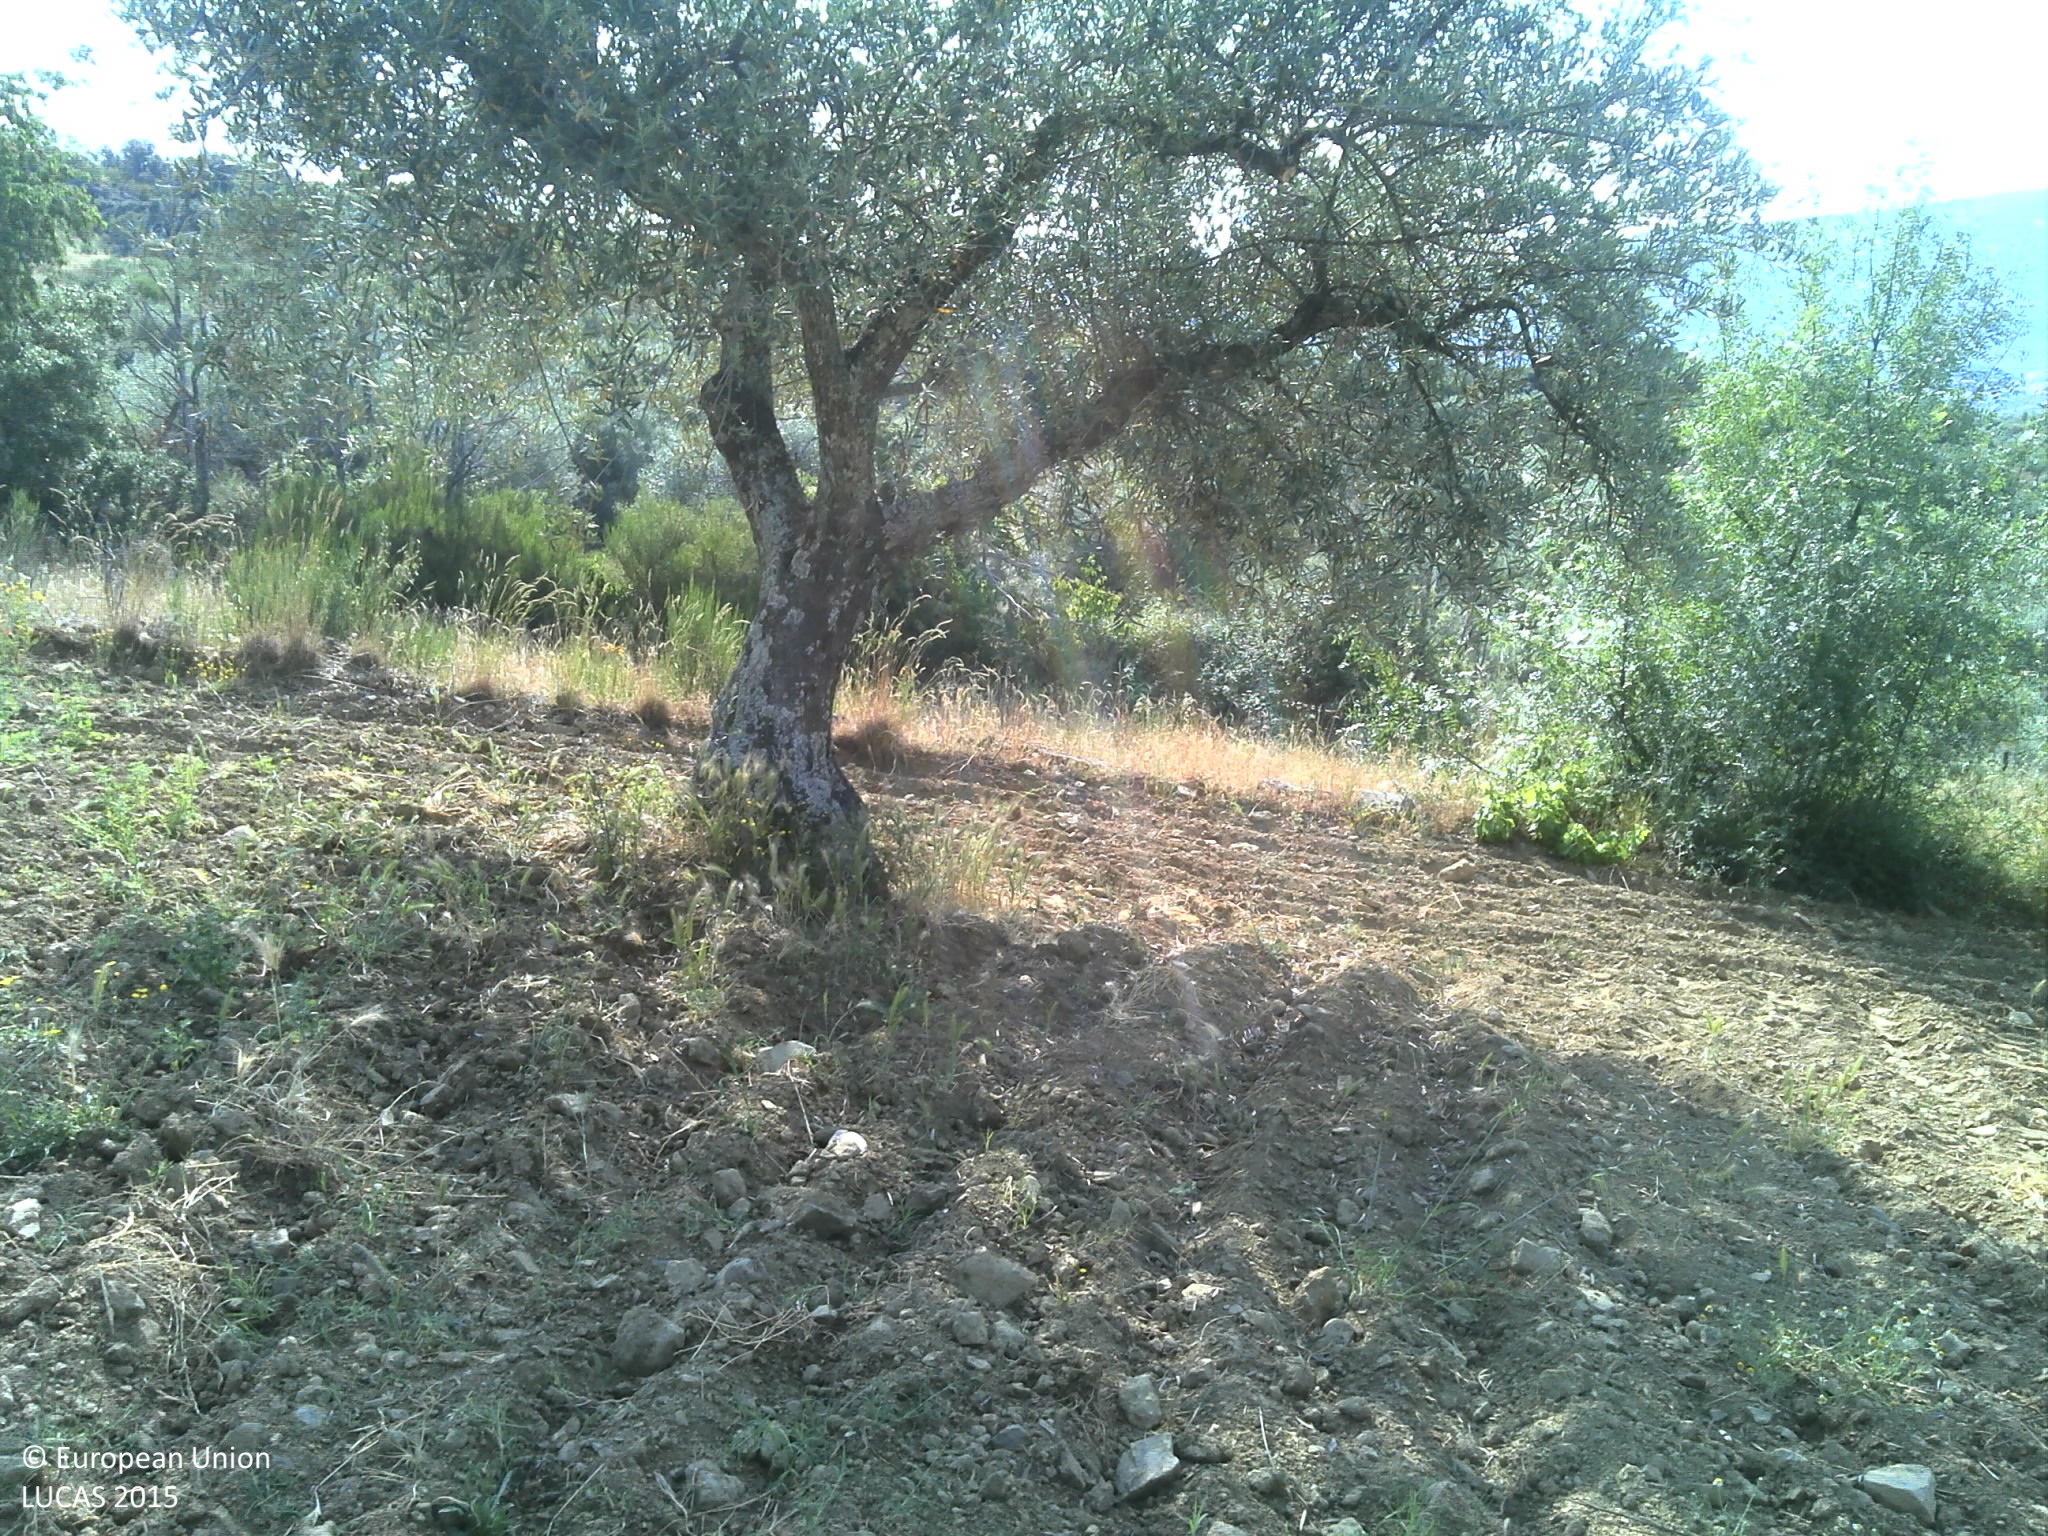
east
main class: Cropland
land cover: Olive groves
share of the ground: 10 - 25 %
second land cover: Spontaneously vegetated surfaces
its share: 10 - 25 %
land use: Agriculture (excluding fallow land and kitchen gardens)
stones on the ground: 10 - 25 %
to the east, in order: Olive groves; Spontaneously vegetated surfaces; Olive groves; Dry stone walls; Grass margins; Tracks; Grass margins; Dry stone walls; Rye; Shruby margins; Dry stone walls; Lines of trees; Olive groves; Broadleaved woodland; Shrubland with sparse tree cover; Tracks; Shruby margins; Lines of trees; Olive groves
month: June
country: PT
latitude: 41.5179
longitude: -6.9985
